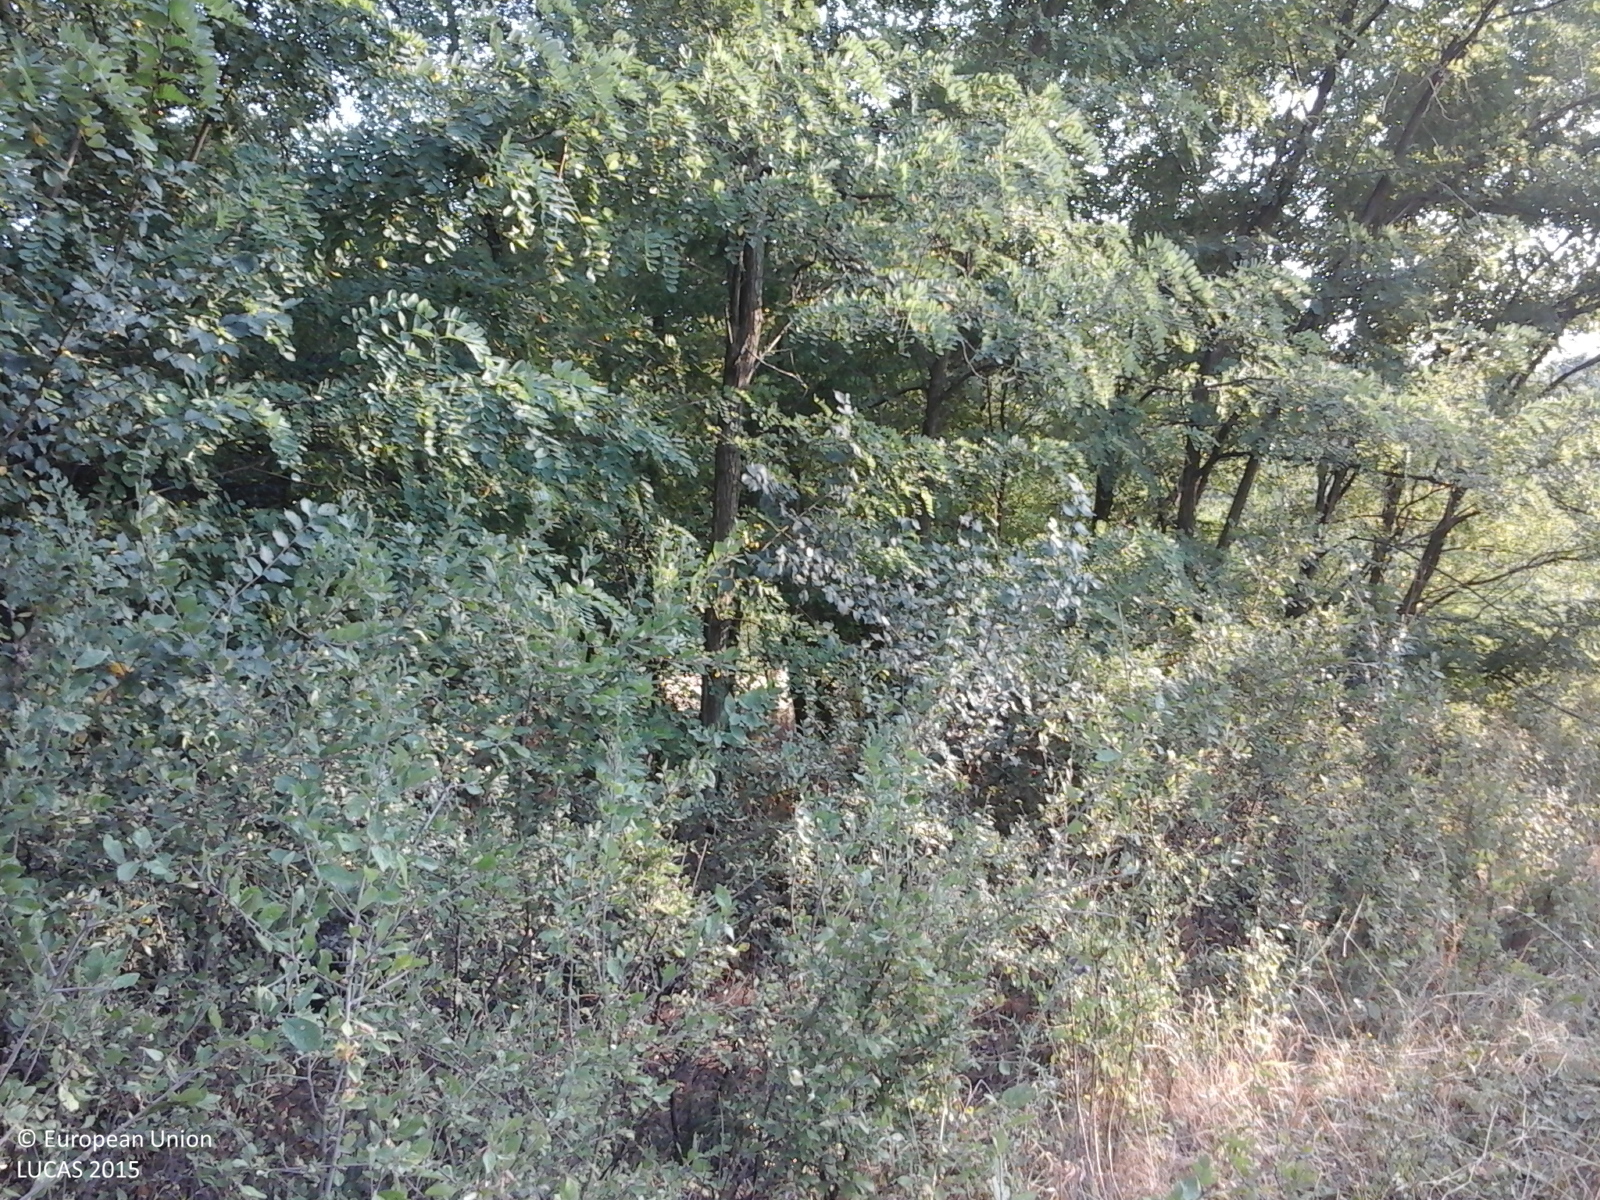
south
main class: Shrubland
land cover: Shrubland with sparse tree cover
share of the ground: > 75 %
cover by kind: shrubs 95 %, broadleaved forest trees 5 %
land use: Semi-natural and natural areas not in use
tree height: < 5 m
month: August
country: RO
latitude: 44.4196
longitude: 23.4531
